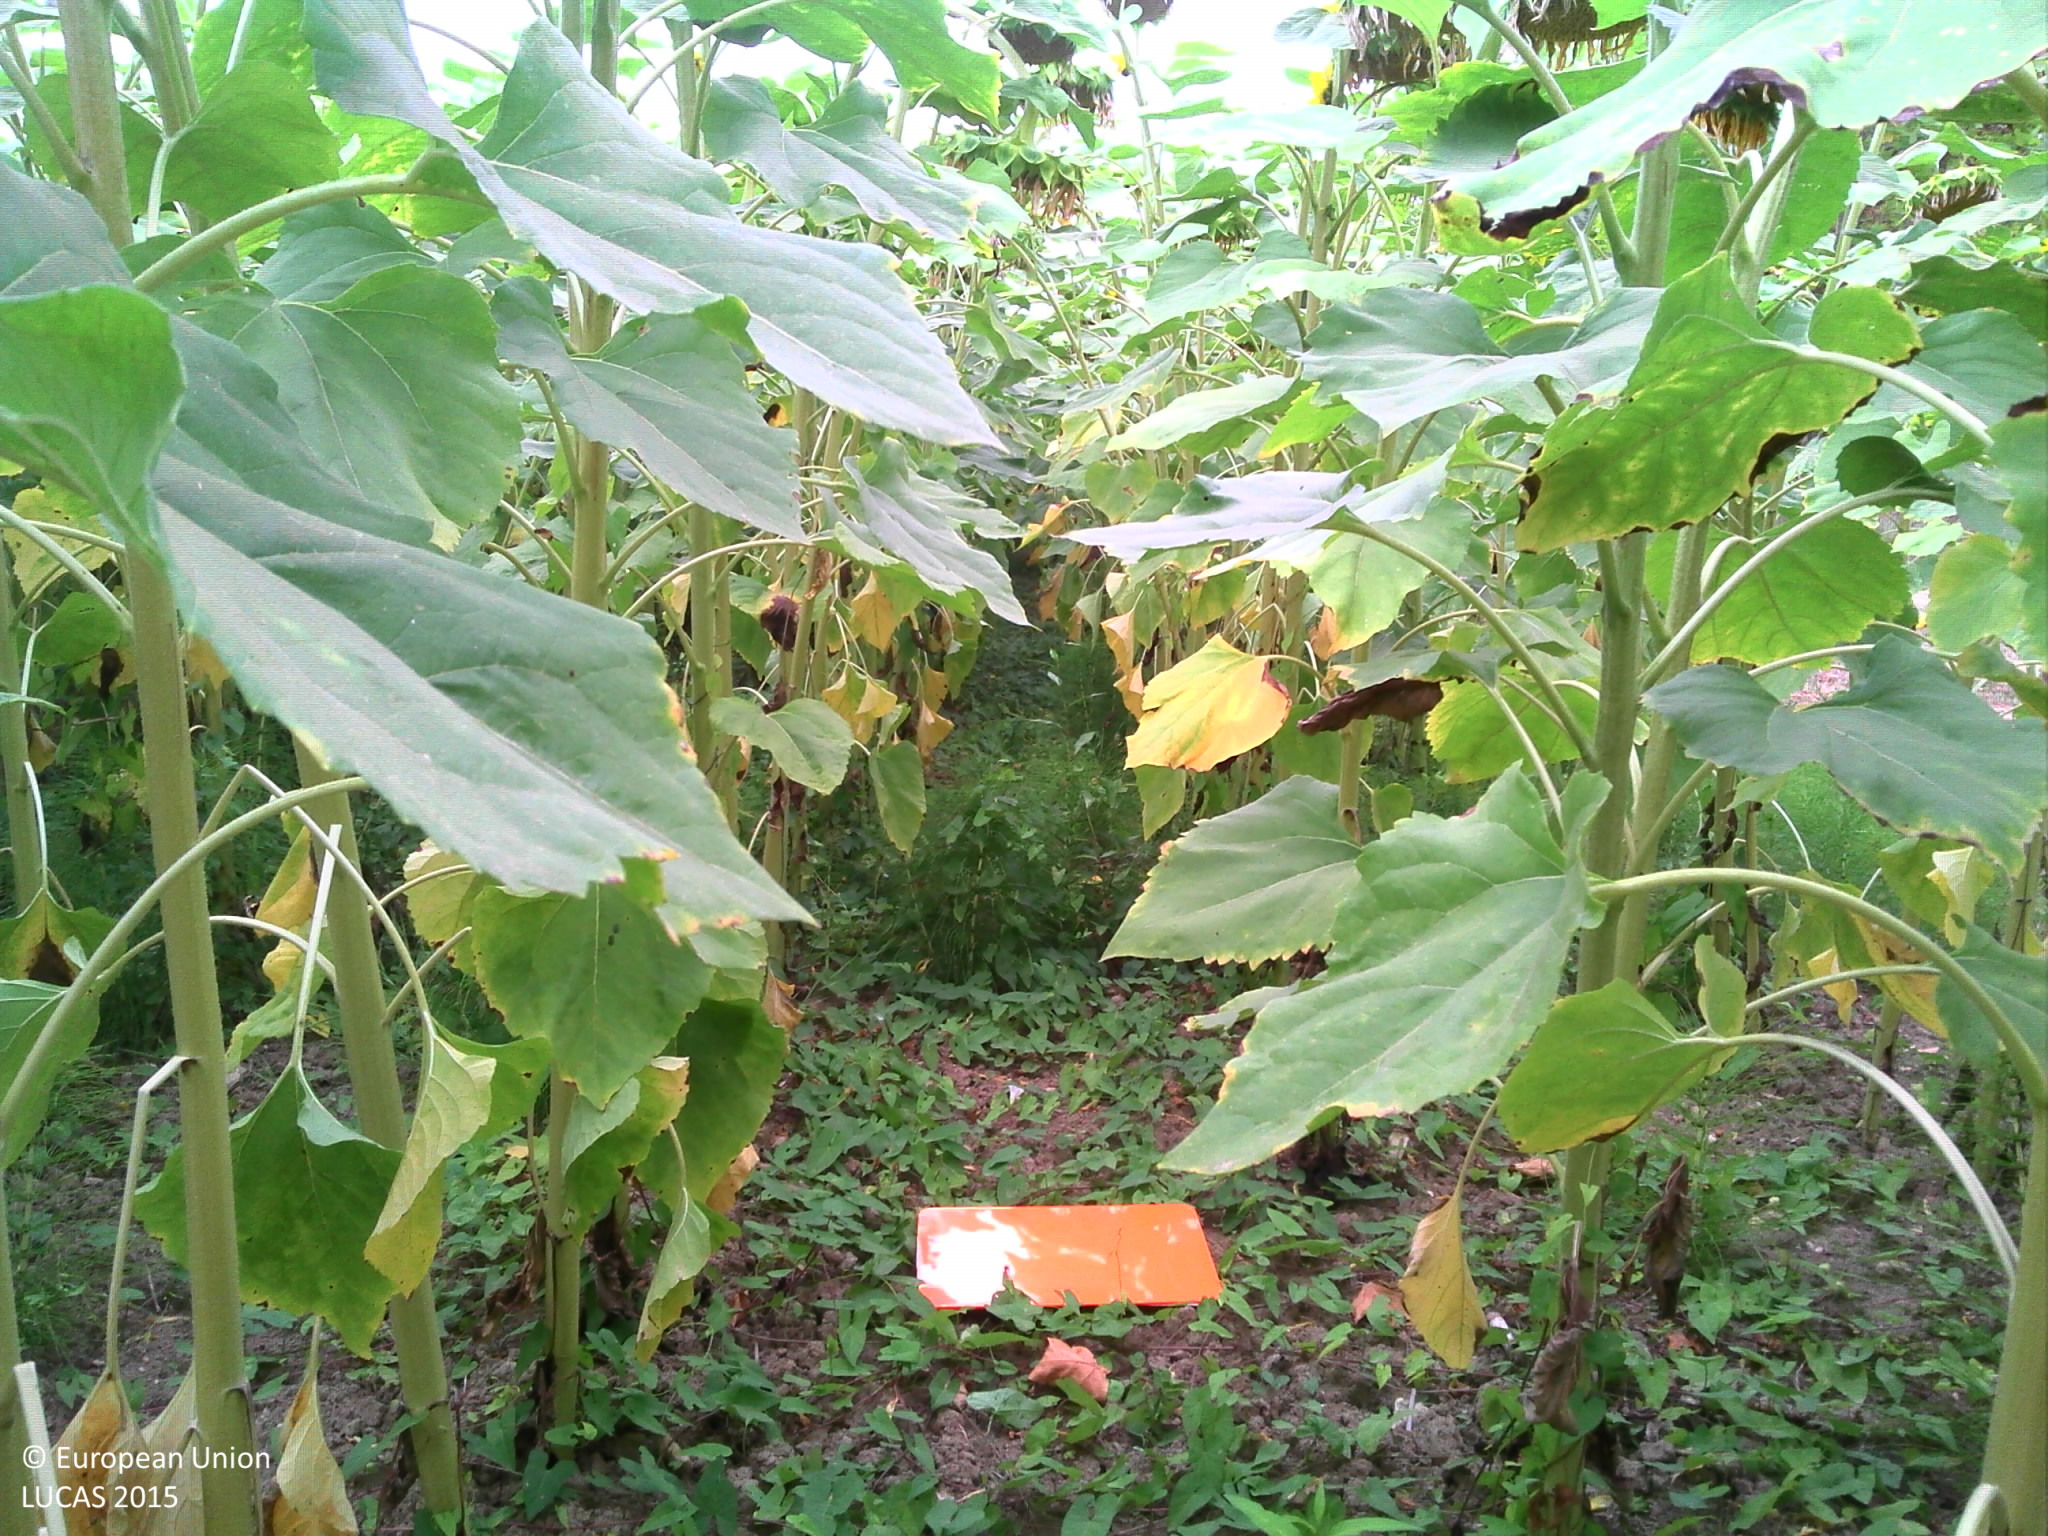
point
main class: Cropland
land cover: Sunflower
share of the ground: > 75 %
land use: Agriculture (excluding fallow land and kitchen gardens)
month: July
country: FR
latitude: 44.3023
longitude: 0.5803
